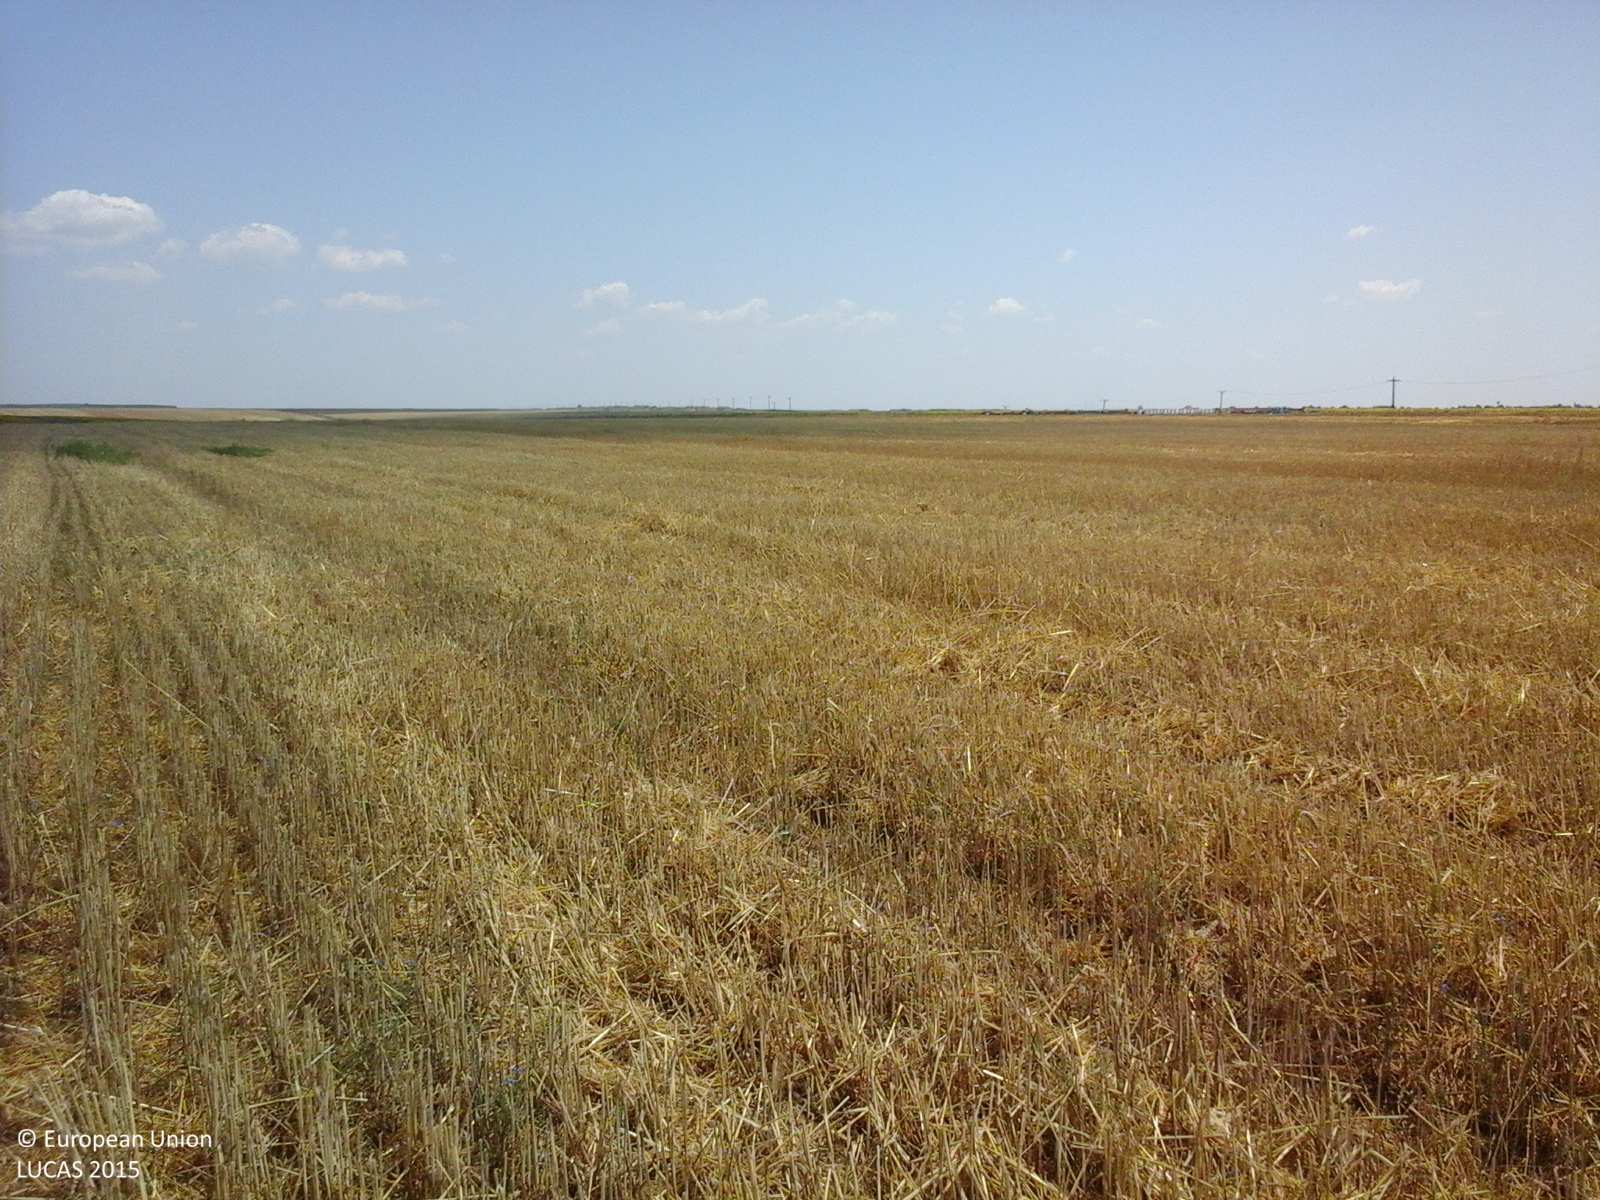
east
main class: Cropland
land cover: Common wheat
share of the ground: 50 - 75 %
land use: Agriculture (excluding fallow land and kitchen gardens)
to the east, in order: Common wheat
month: July
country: RO
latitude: 44.2048
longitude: 24.6246
